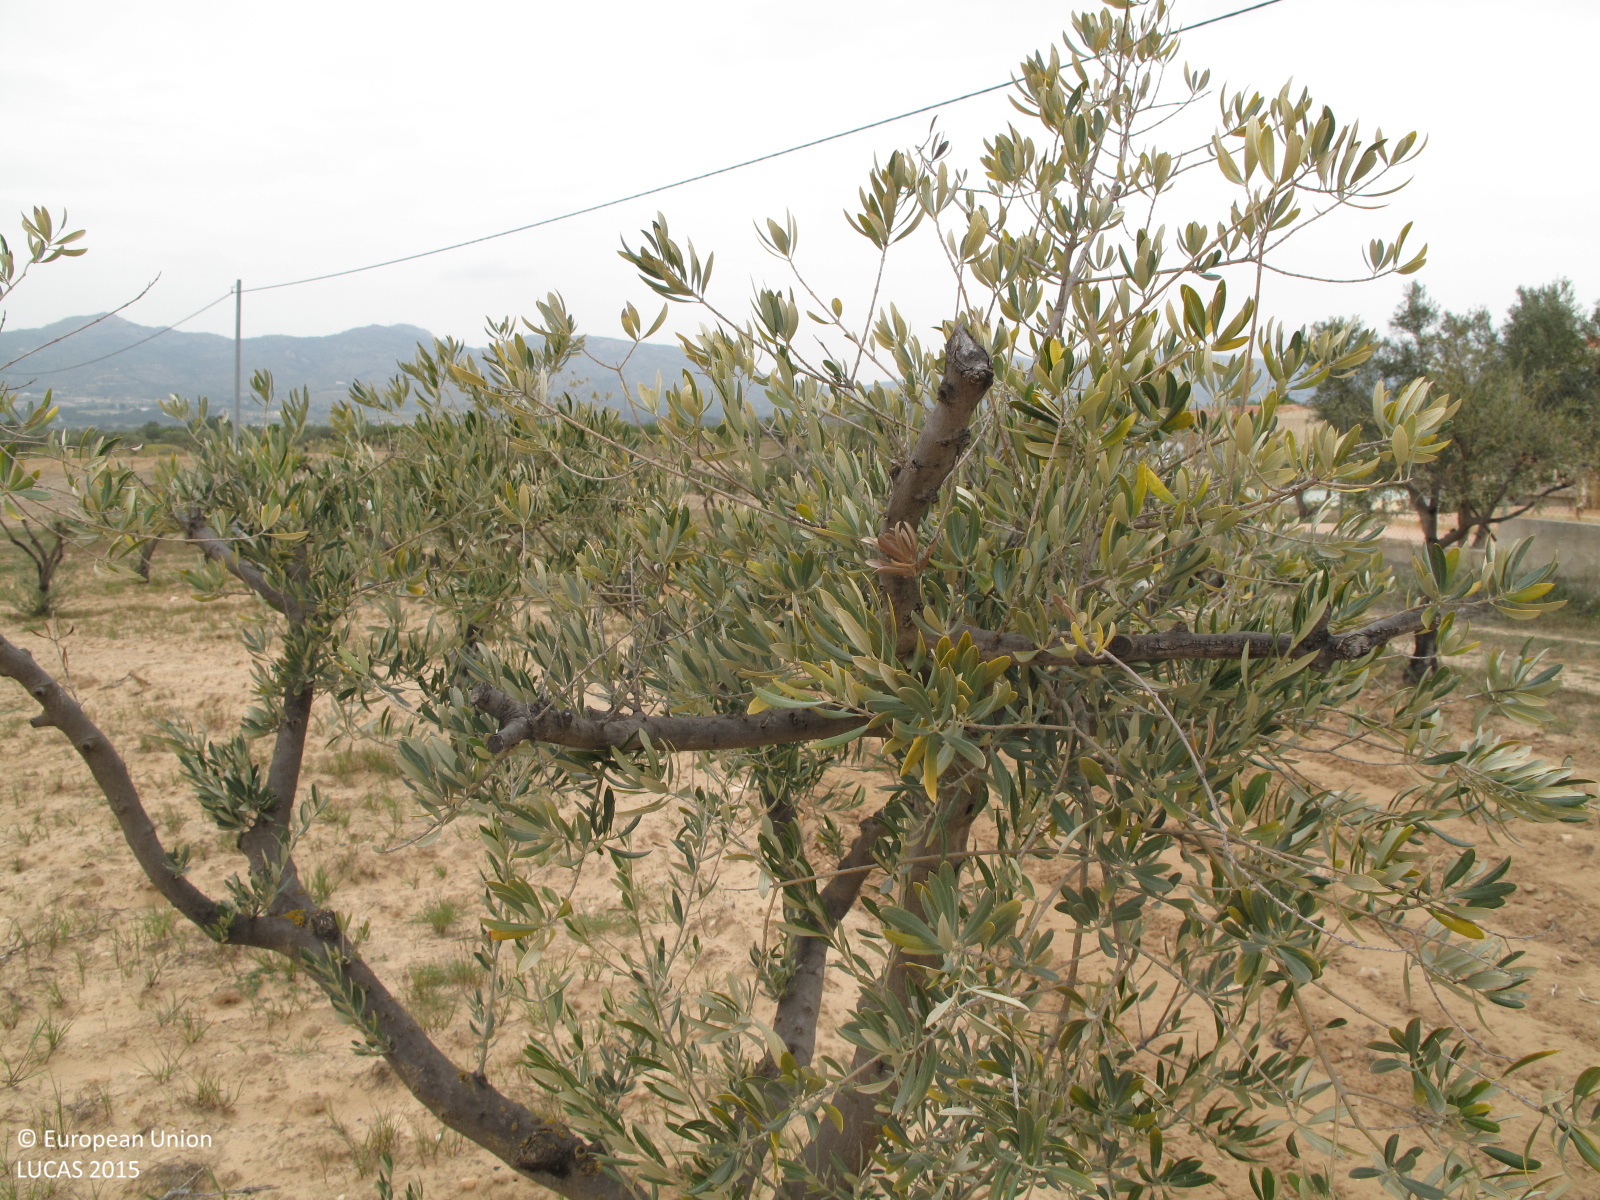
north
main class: Cropland
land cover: Olive groves
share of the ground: < 10 %
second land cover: Other bare soil
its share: > 75 %
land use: Agriculture (excluding fallow land and kitchen gardens)
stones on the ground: 10 - 25 %
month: April
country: ES
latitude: 38.5574
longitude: -0.7875
